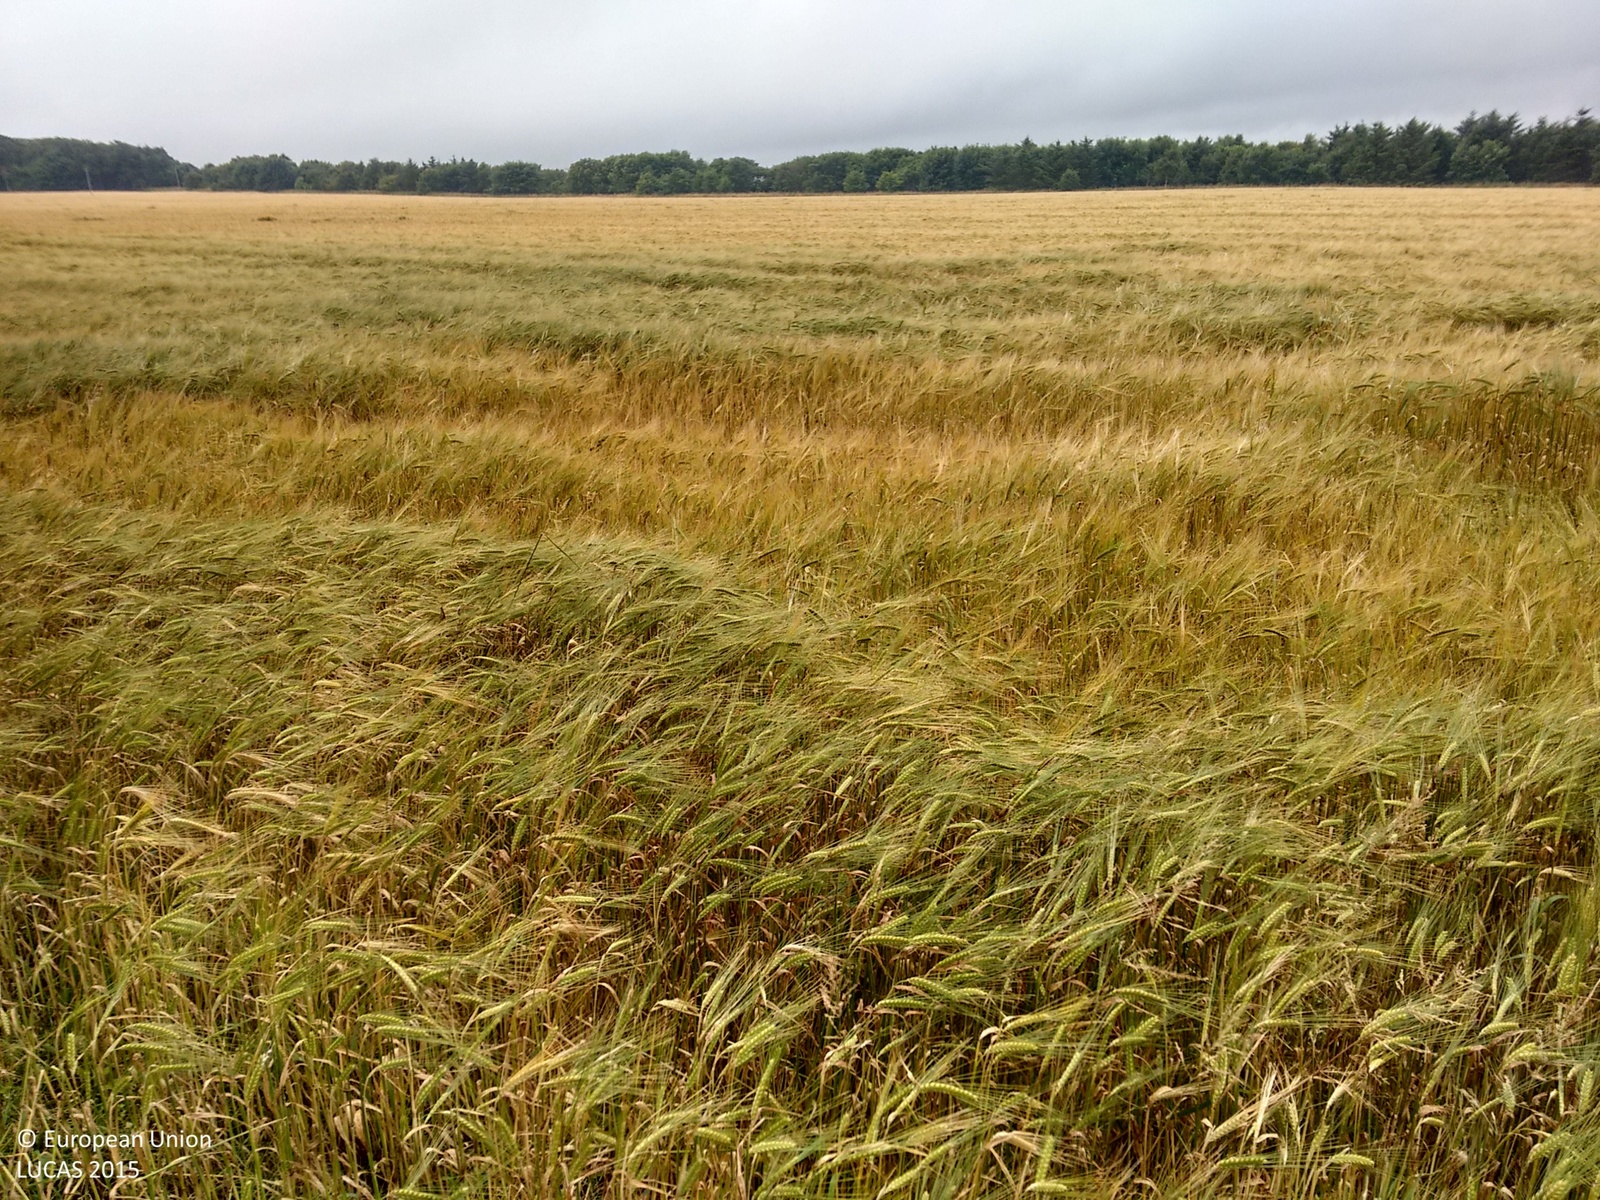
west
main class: Cropland
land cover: Common wheat
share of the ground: > 75 %
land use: Agriculture (excluding fallow land and kitchen gardens)
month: August
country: GB
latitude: 58.4450
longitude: -3.1651
